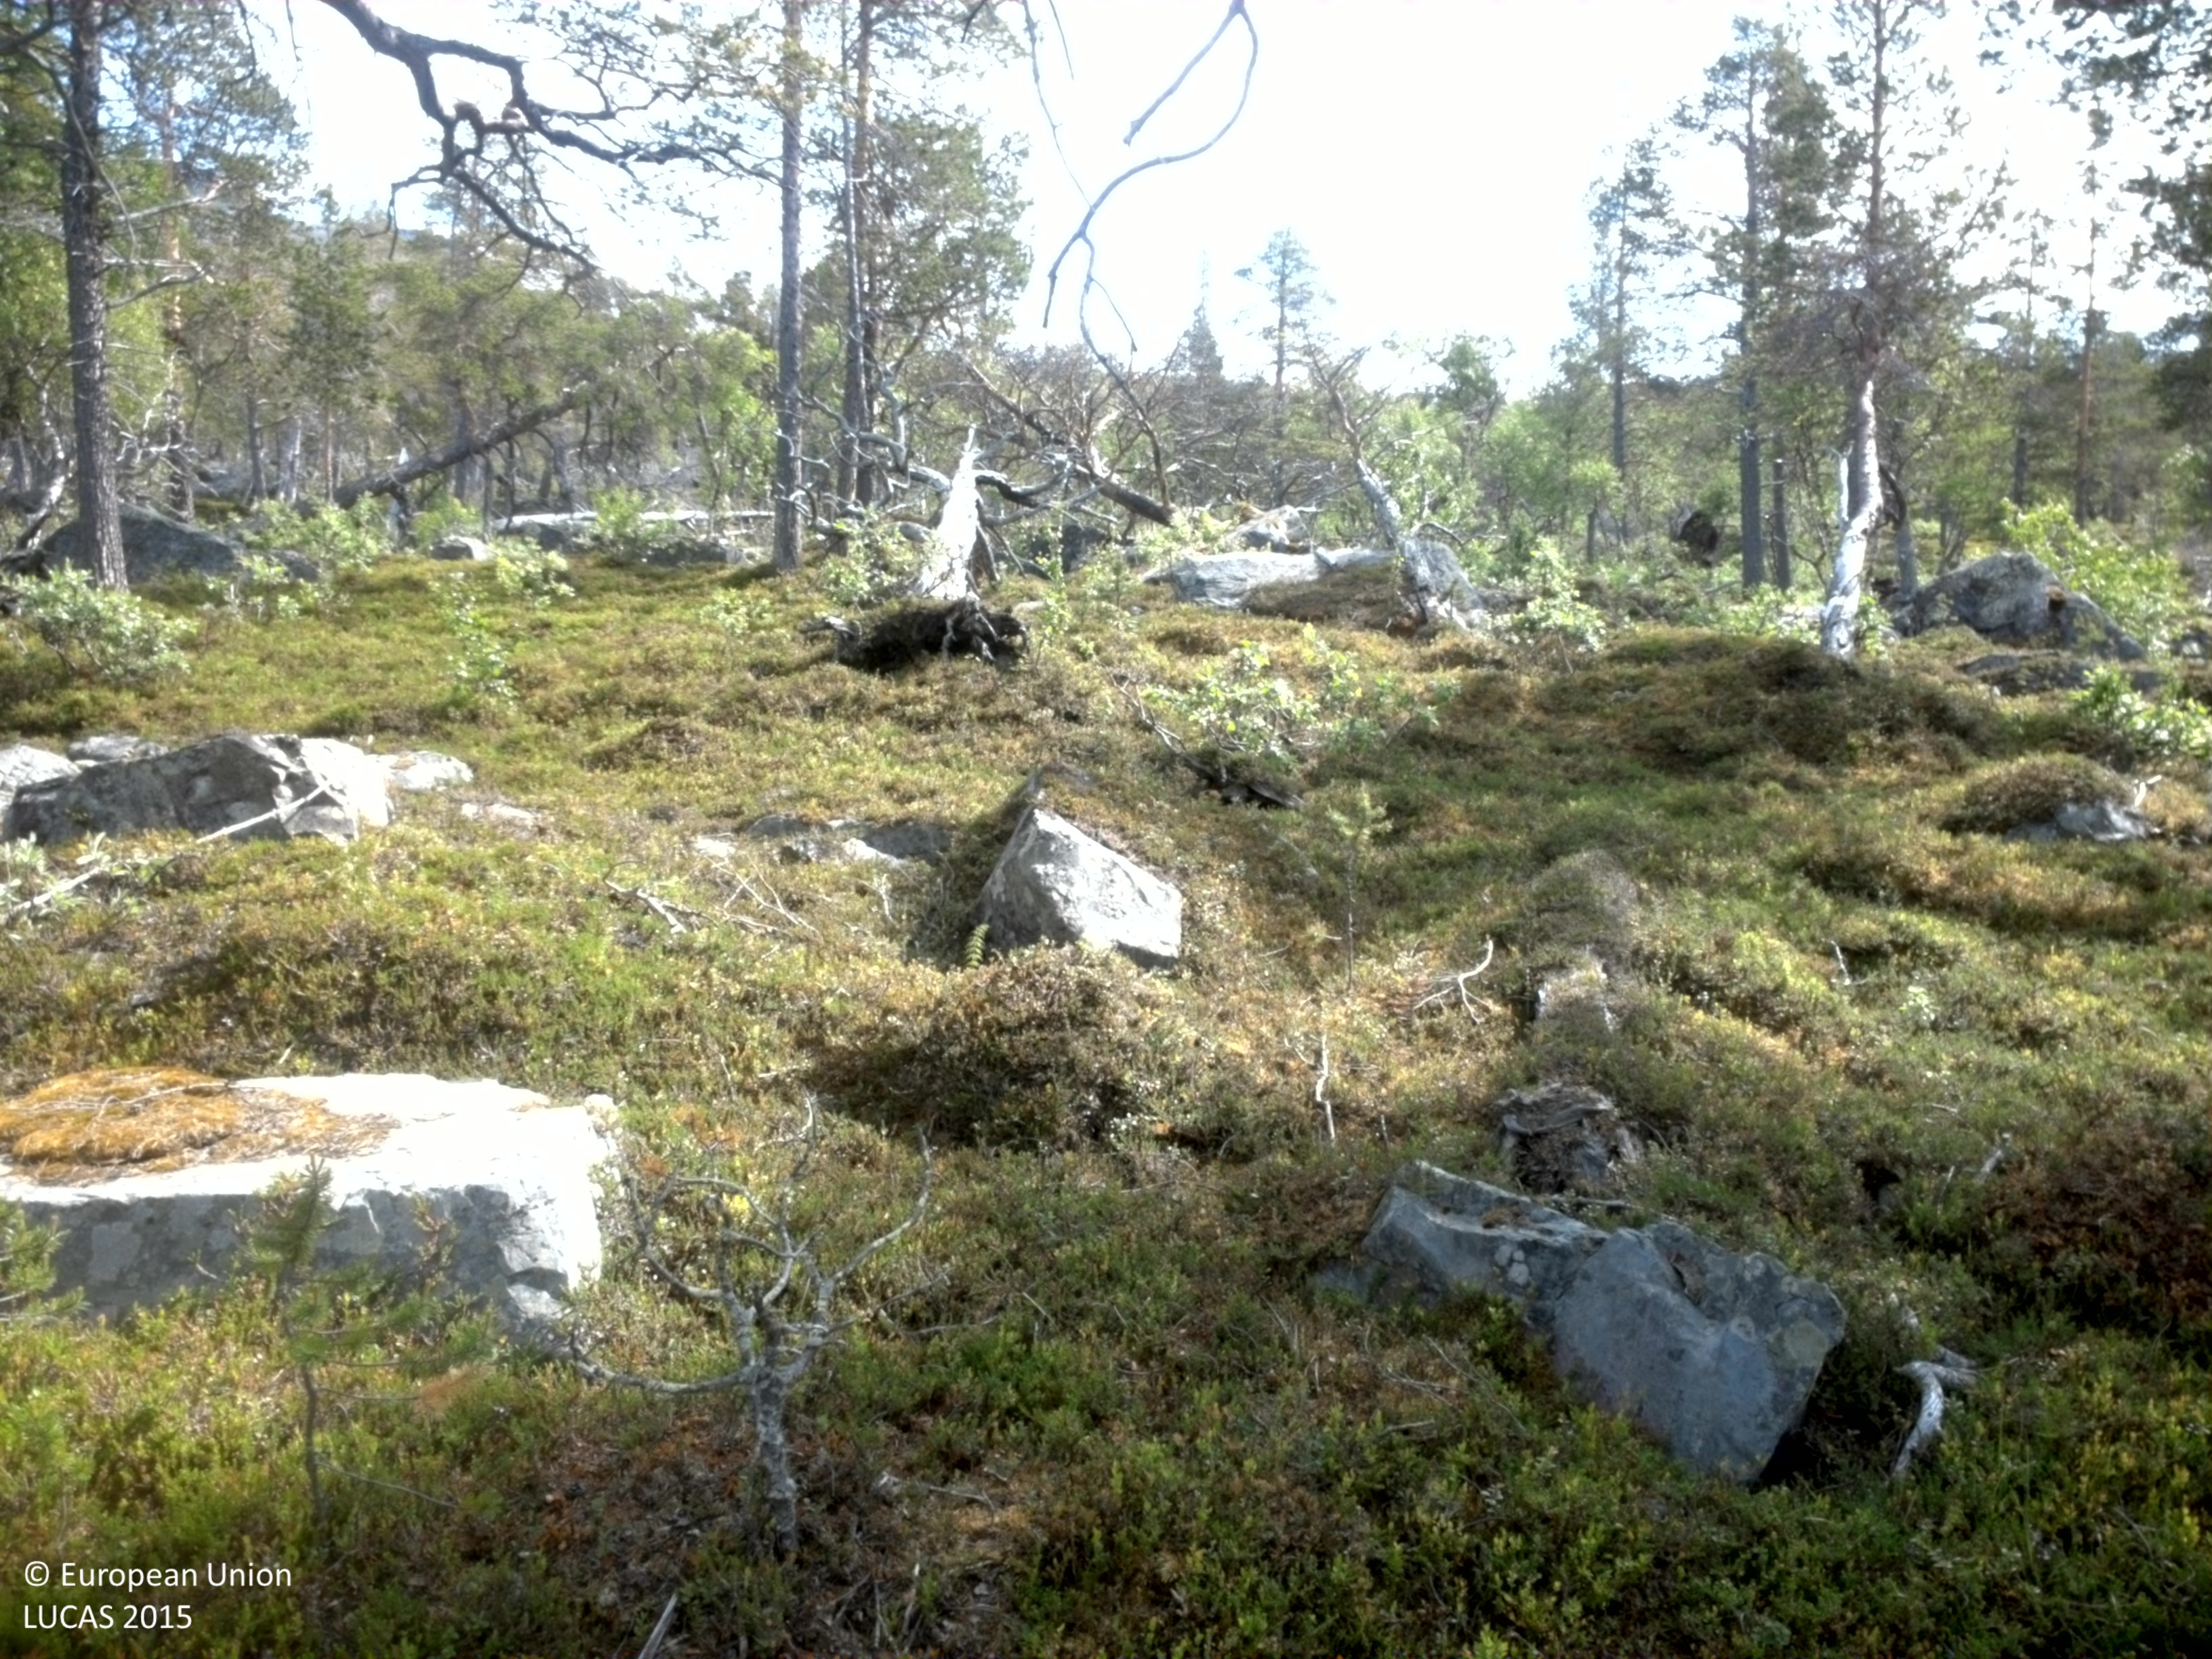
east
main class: Woodland
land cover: Pine dominated coniferous woodland
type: boreal forest
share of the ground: 10 - 25 %
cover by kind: shrubs 60 %, coniferous forest trees 20 %, consolidated bare surface 15 %, broadleaved forest trees 5 %
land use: Forestry
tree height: > 5 m
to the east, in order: Pine dominated coniferous woodland; Rocks and stones; Pine dominated mixed woodland; Broadleaved woodland
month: July
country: SE
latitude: 67.4714
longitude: 18.3849
